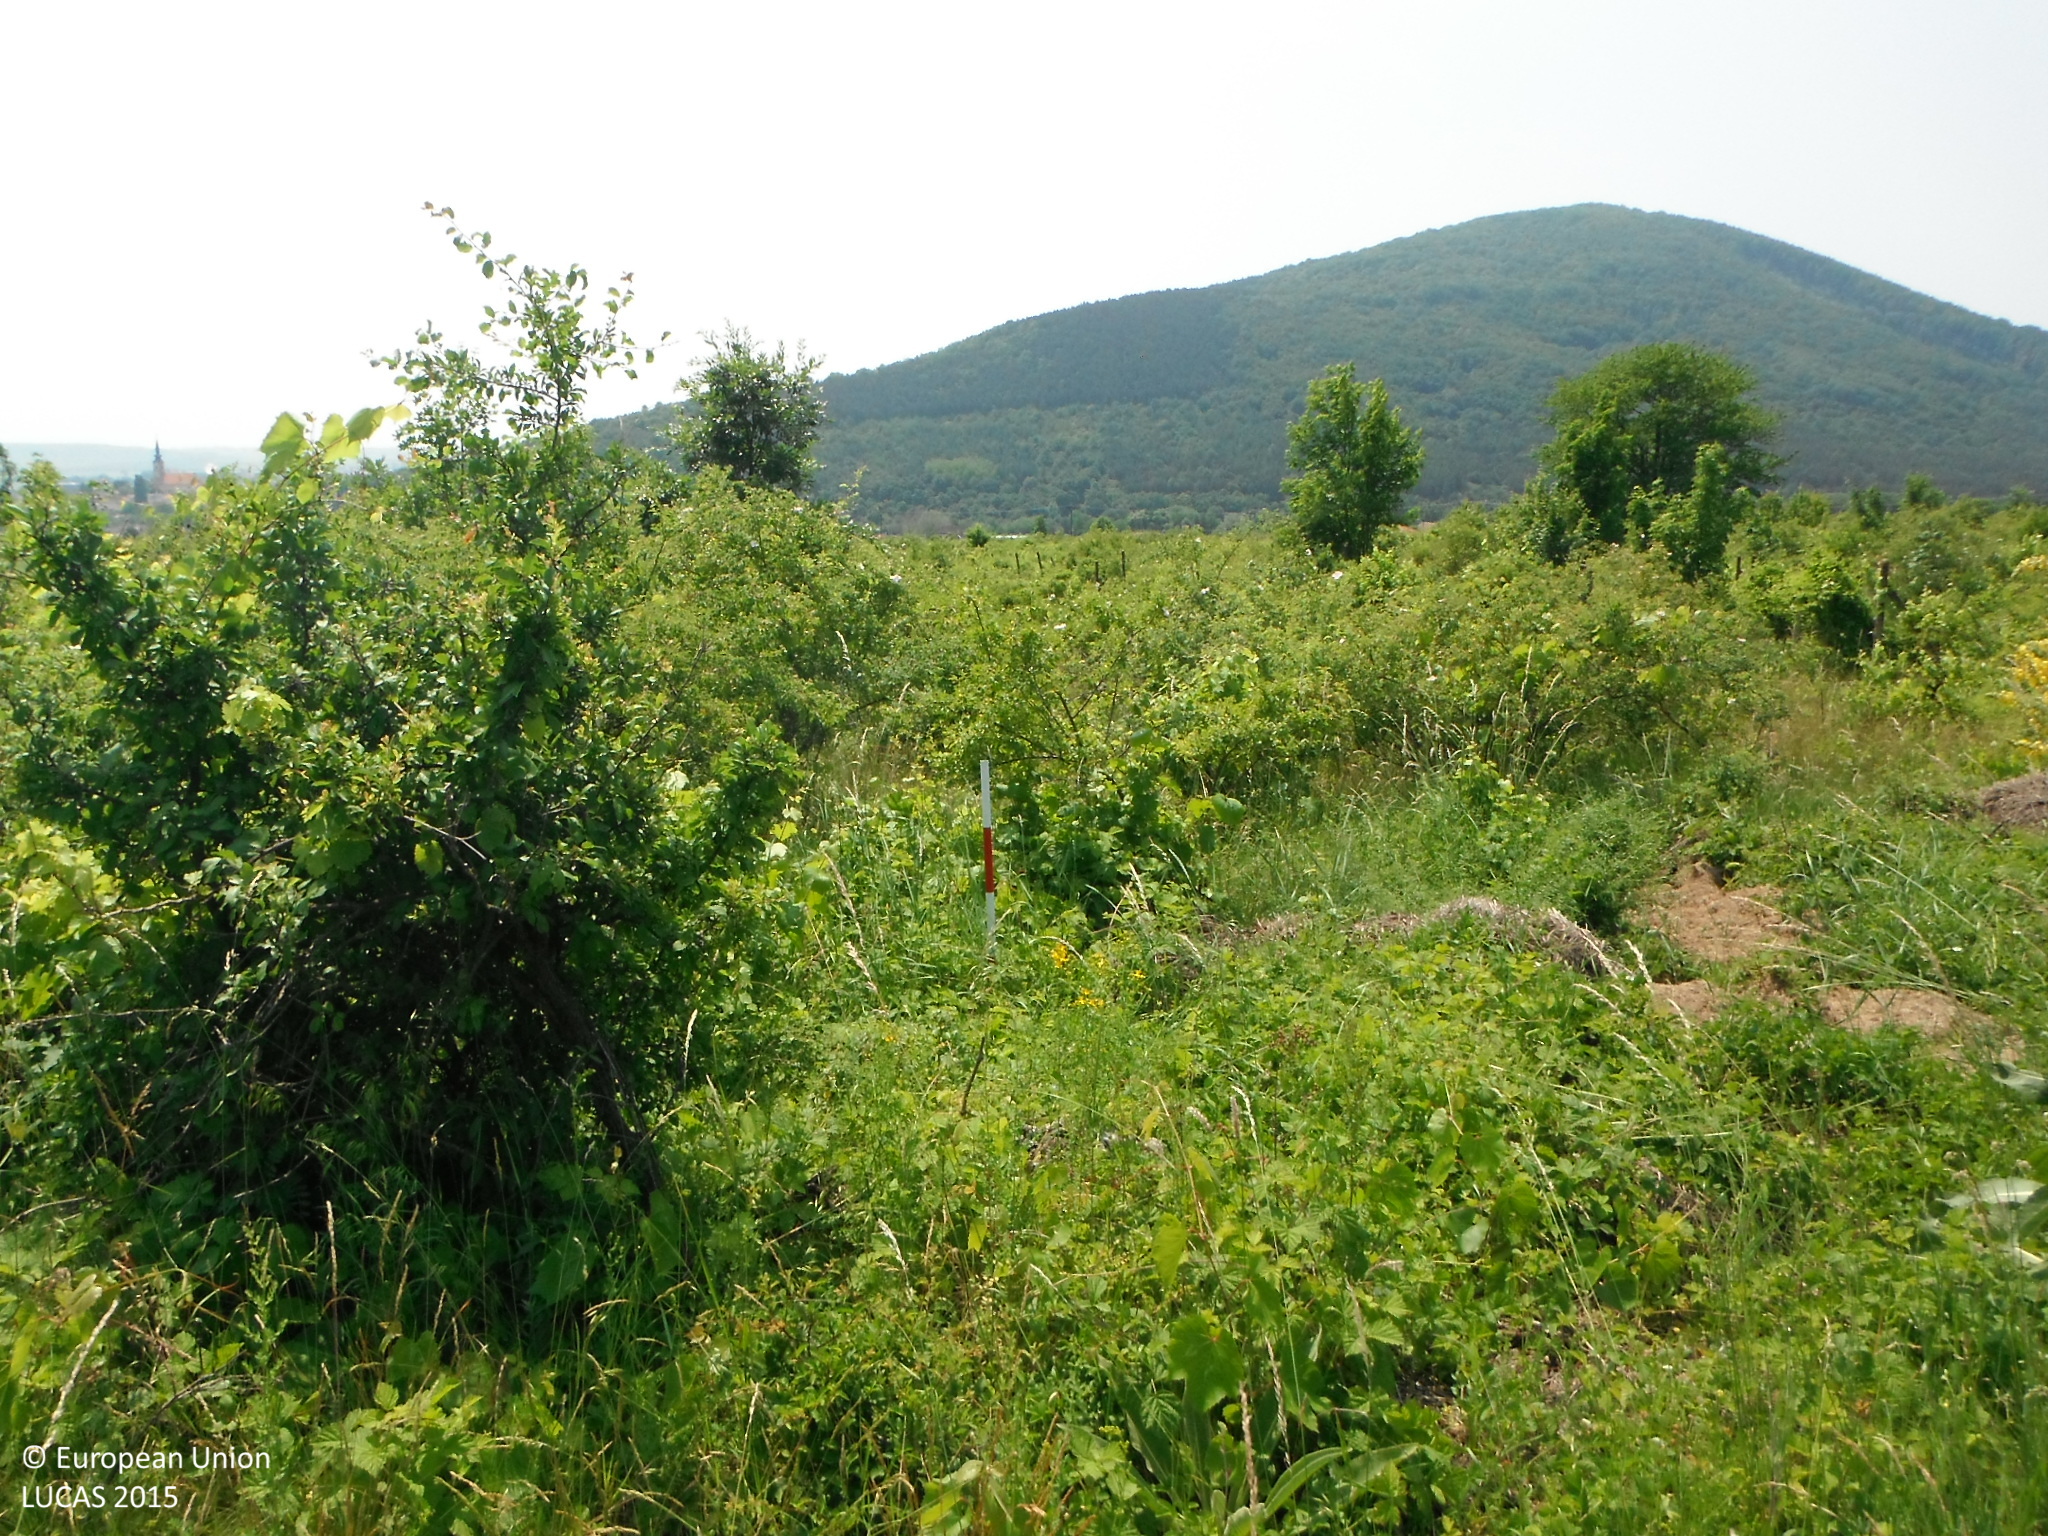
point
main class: Cropland
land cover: Vineyards
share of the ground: 50 - 75 %
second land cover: Shrubland without tree cover
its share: 50 - 75 %
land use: Abandoned areas
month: June
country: SK
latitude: 48.4781
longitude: 17.4371
